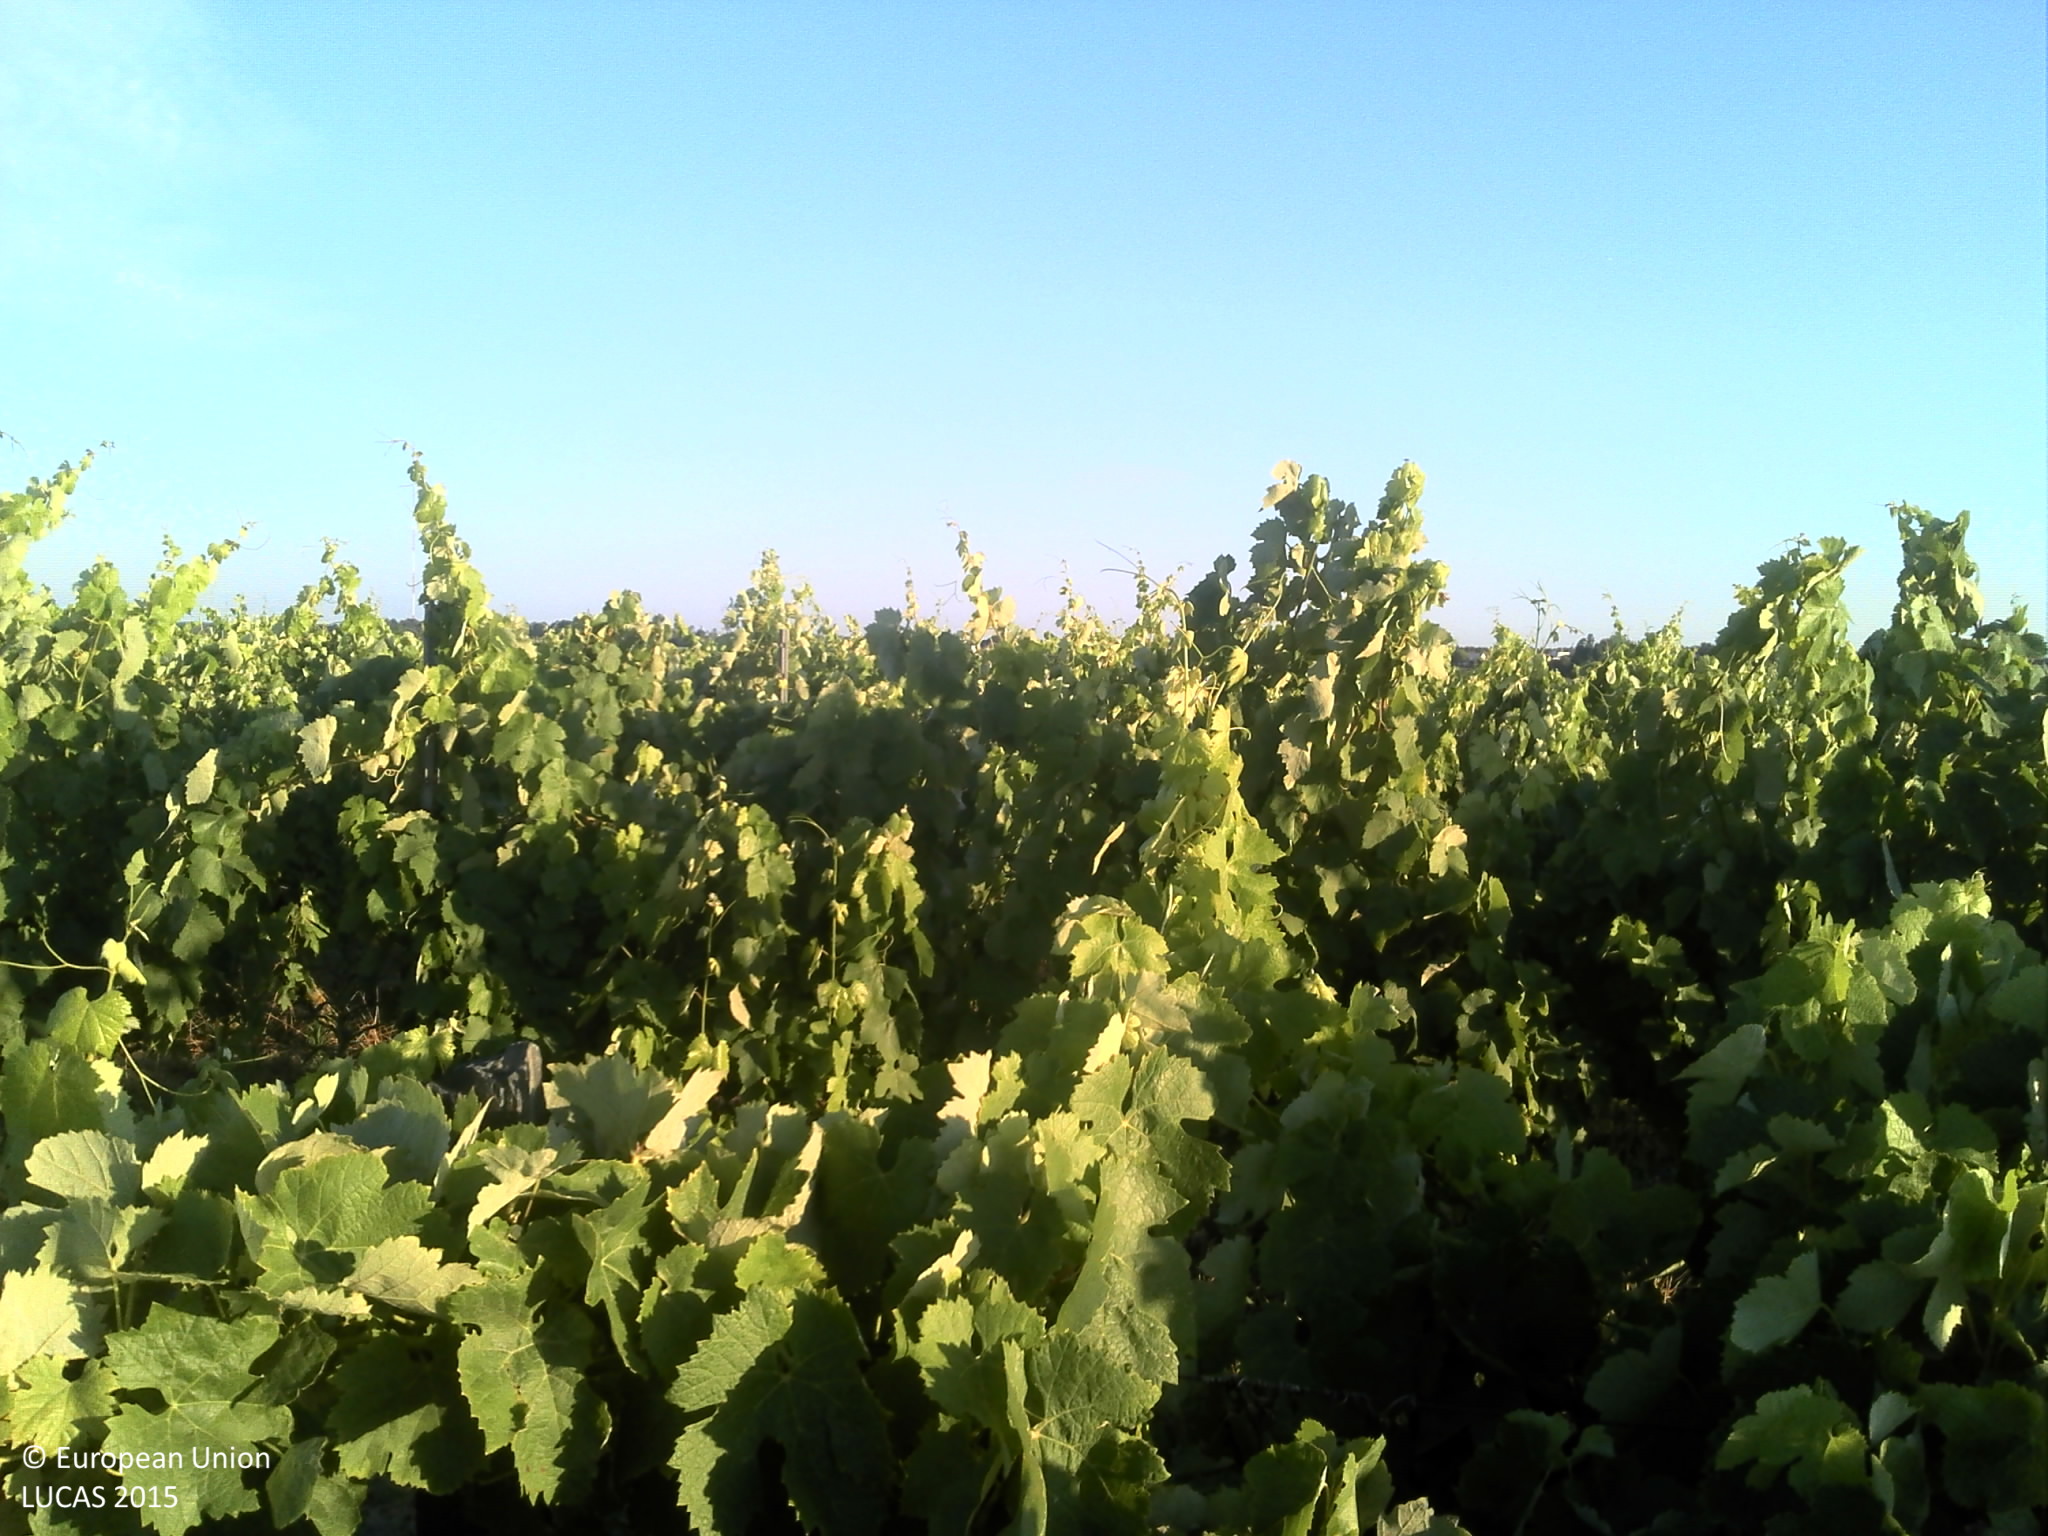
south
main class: Cropland
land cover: Vineyards
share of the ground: 25 - 50 %
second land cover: Grassland without tree/shrub cover
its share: 50 - 75 %
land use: Agriculture (excluding fallow land and kitchen gardens)
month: June
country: PT
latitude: 39.1170
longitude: -8.7032
